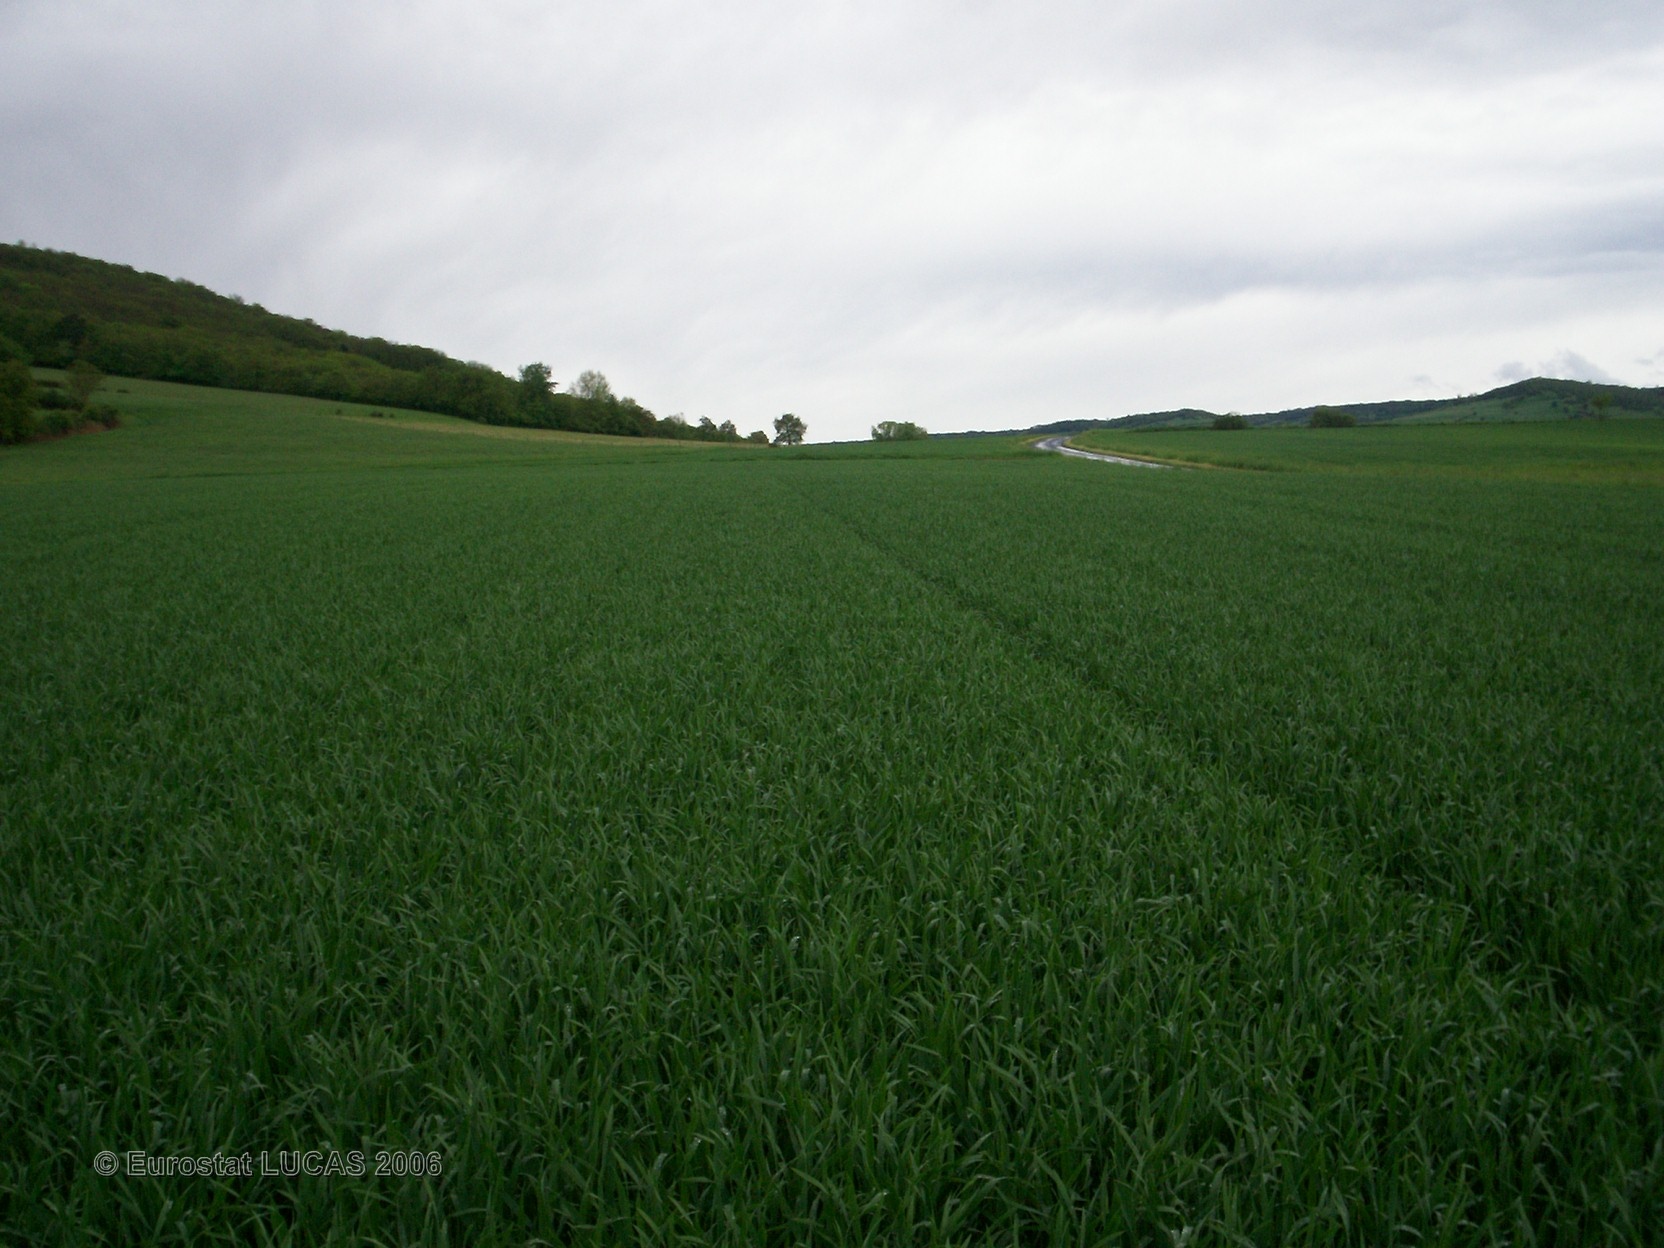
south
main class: Cropland
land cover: Common wheat
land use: Agriculture (excluding fallow land and kitchen gardens)
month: May
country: FR
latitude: 45.4306
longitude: 3.2140
